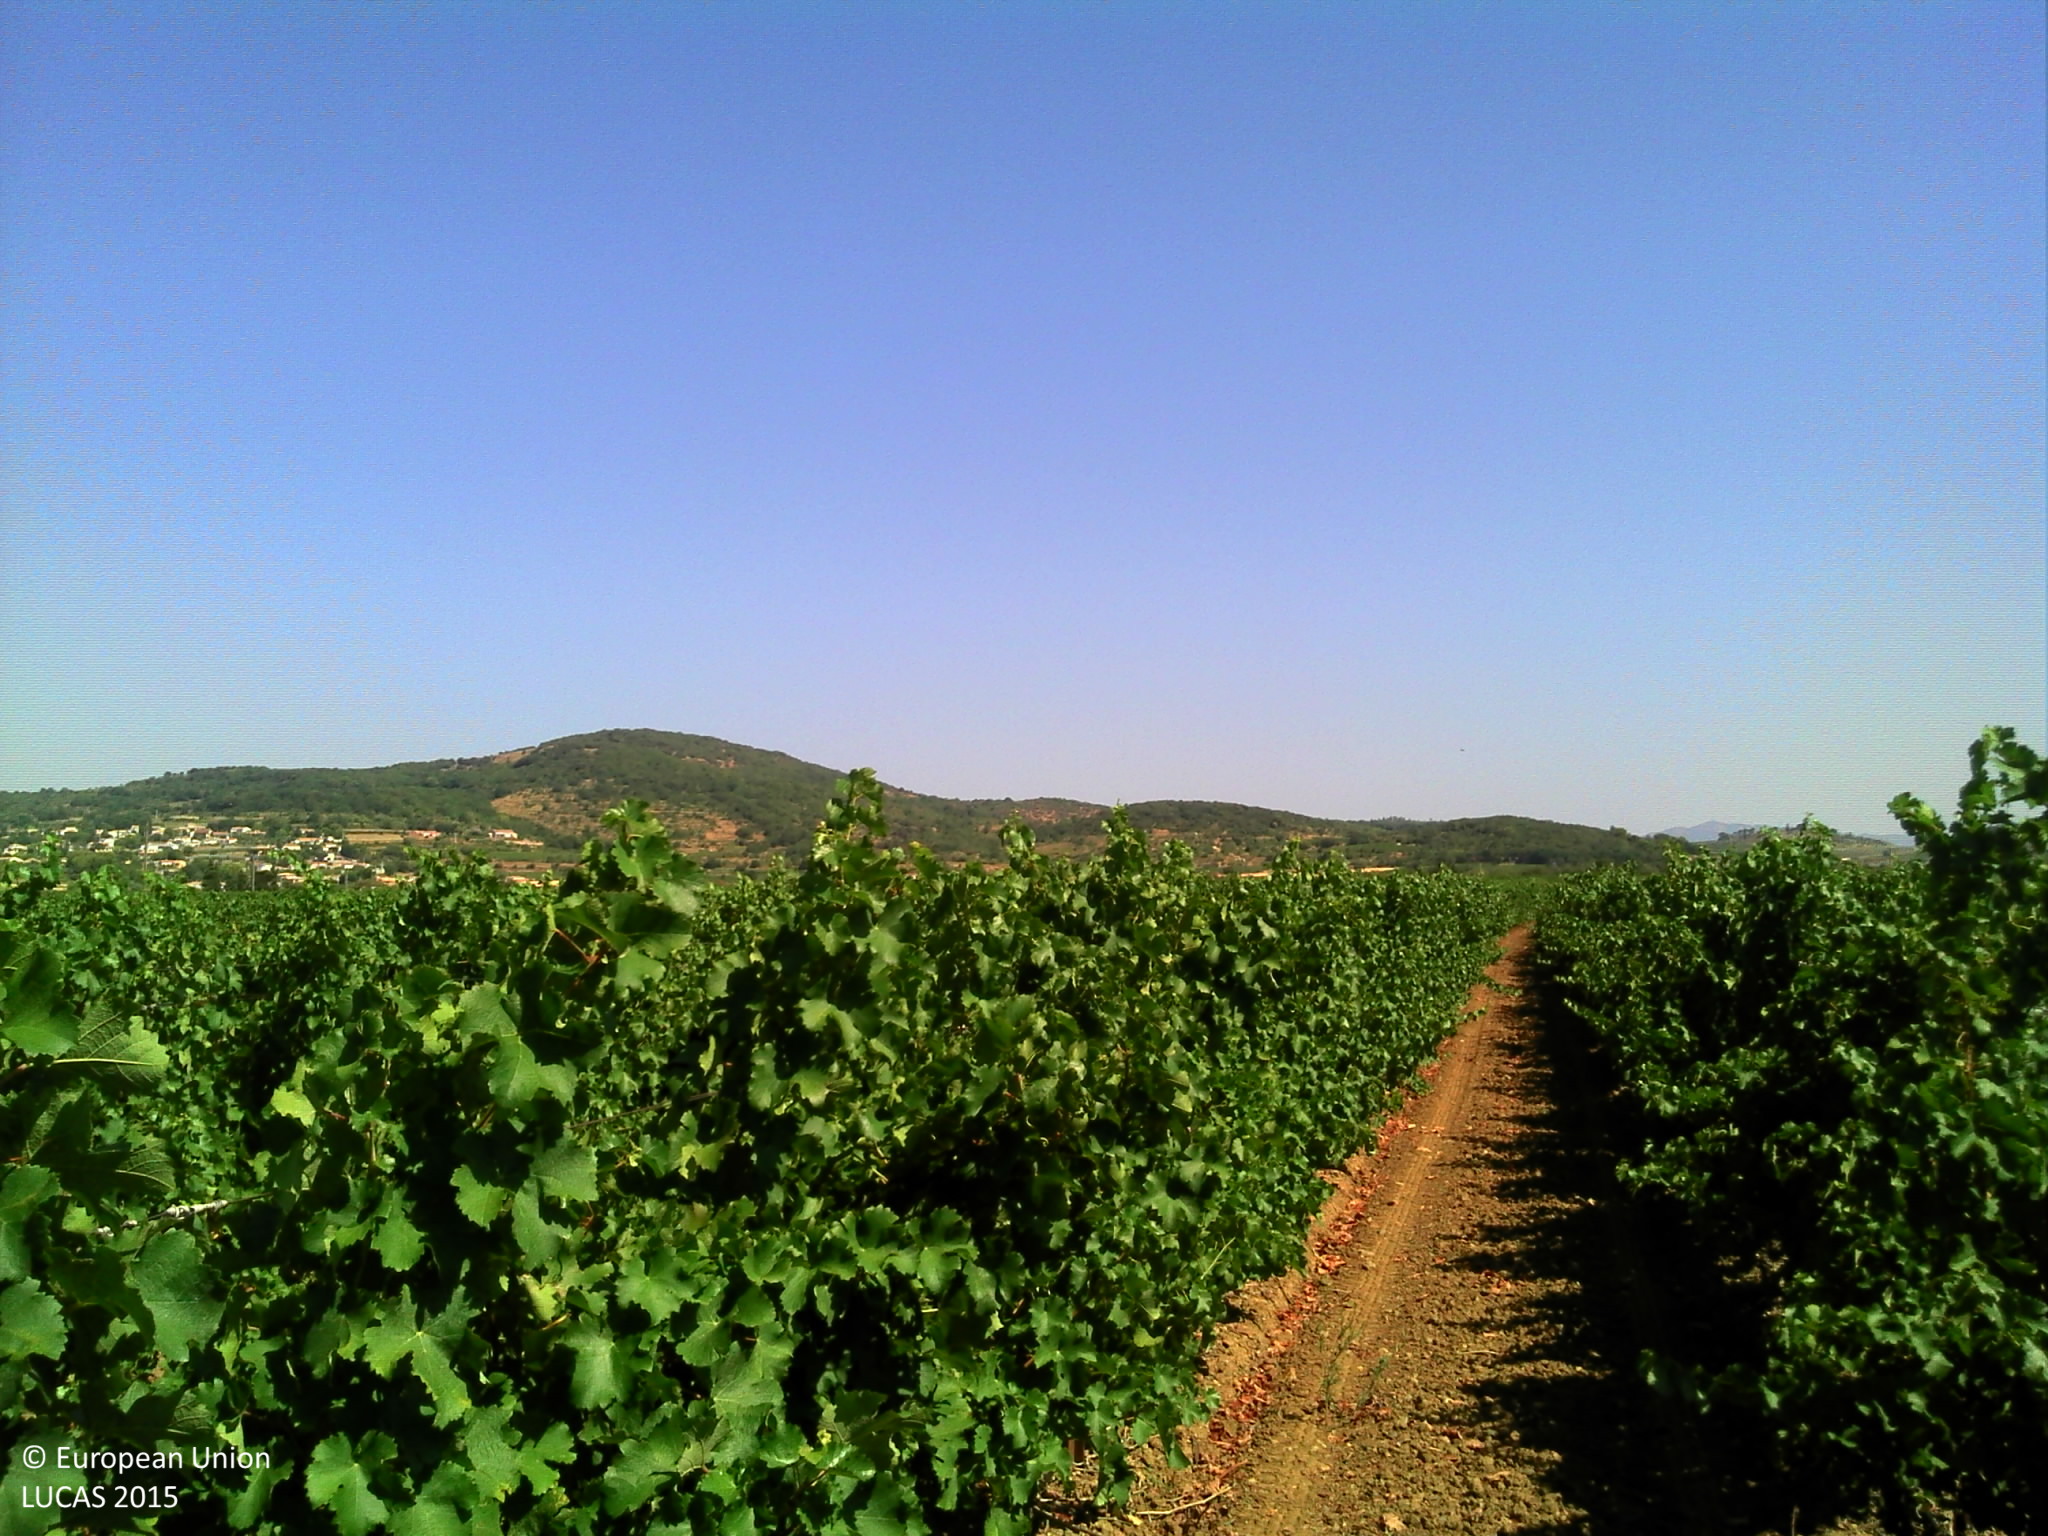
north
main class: Cropland
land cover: Vineyards
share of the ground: 10 - 25 %
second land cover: Other bare soil
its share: > 75 %
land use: Agriculture (excluding fallow land and kitchen gardens)
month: August
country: FR
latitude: 43.5620
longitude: 3.4102
